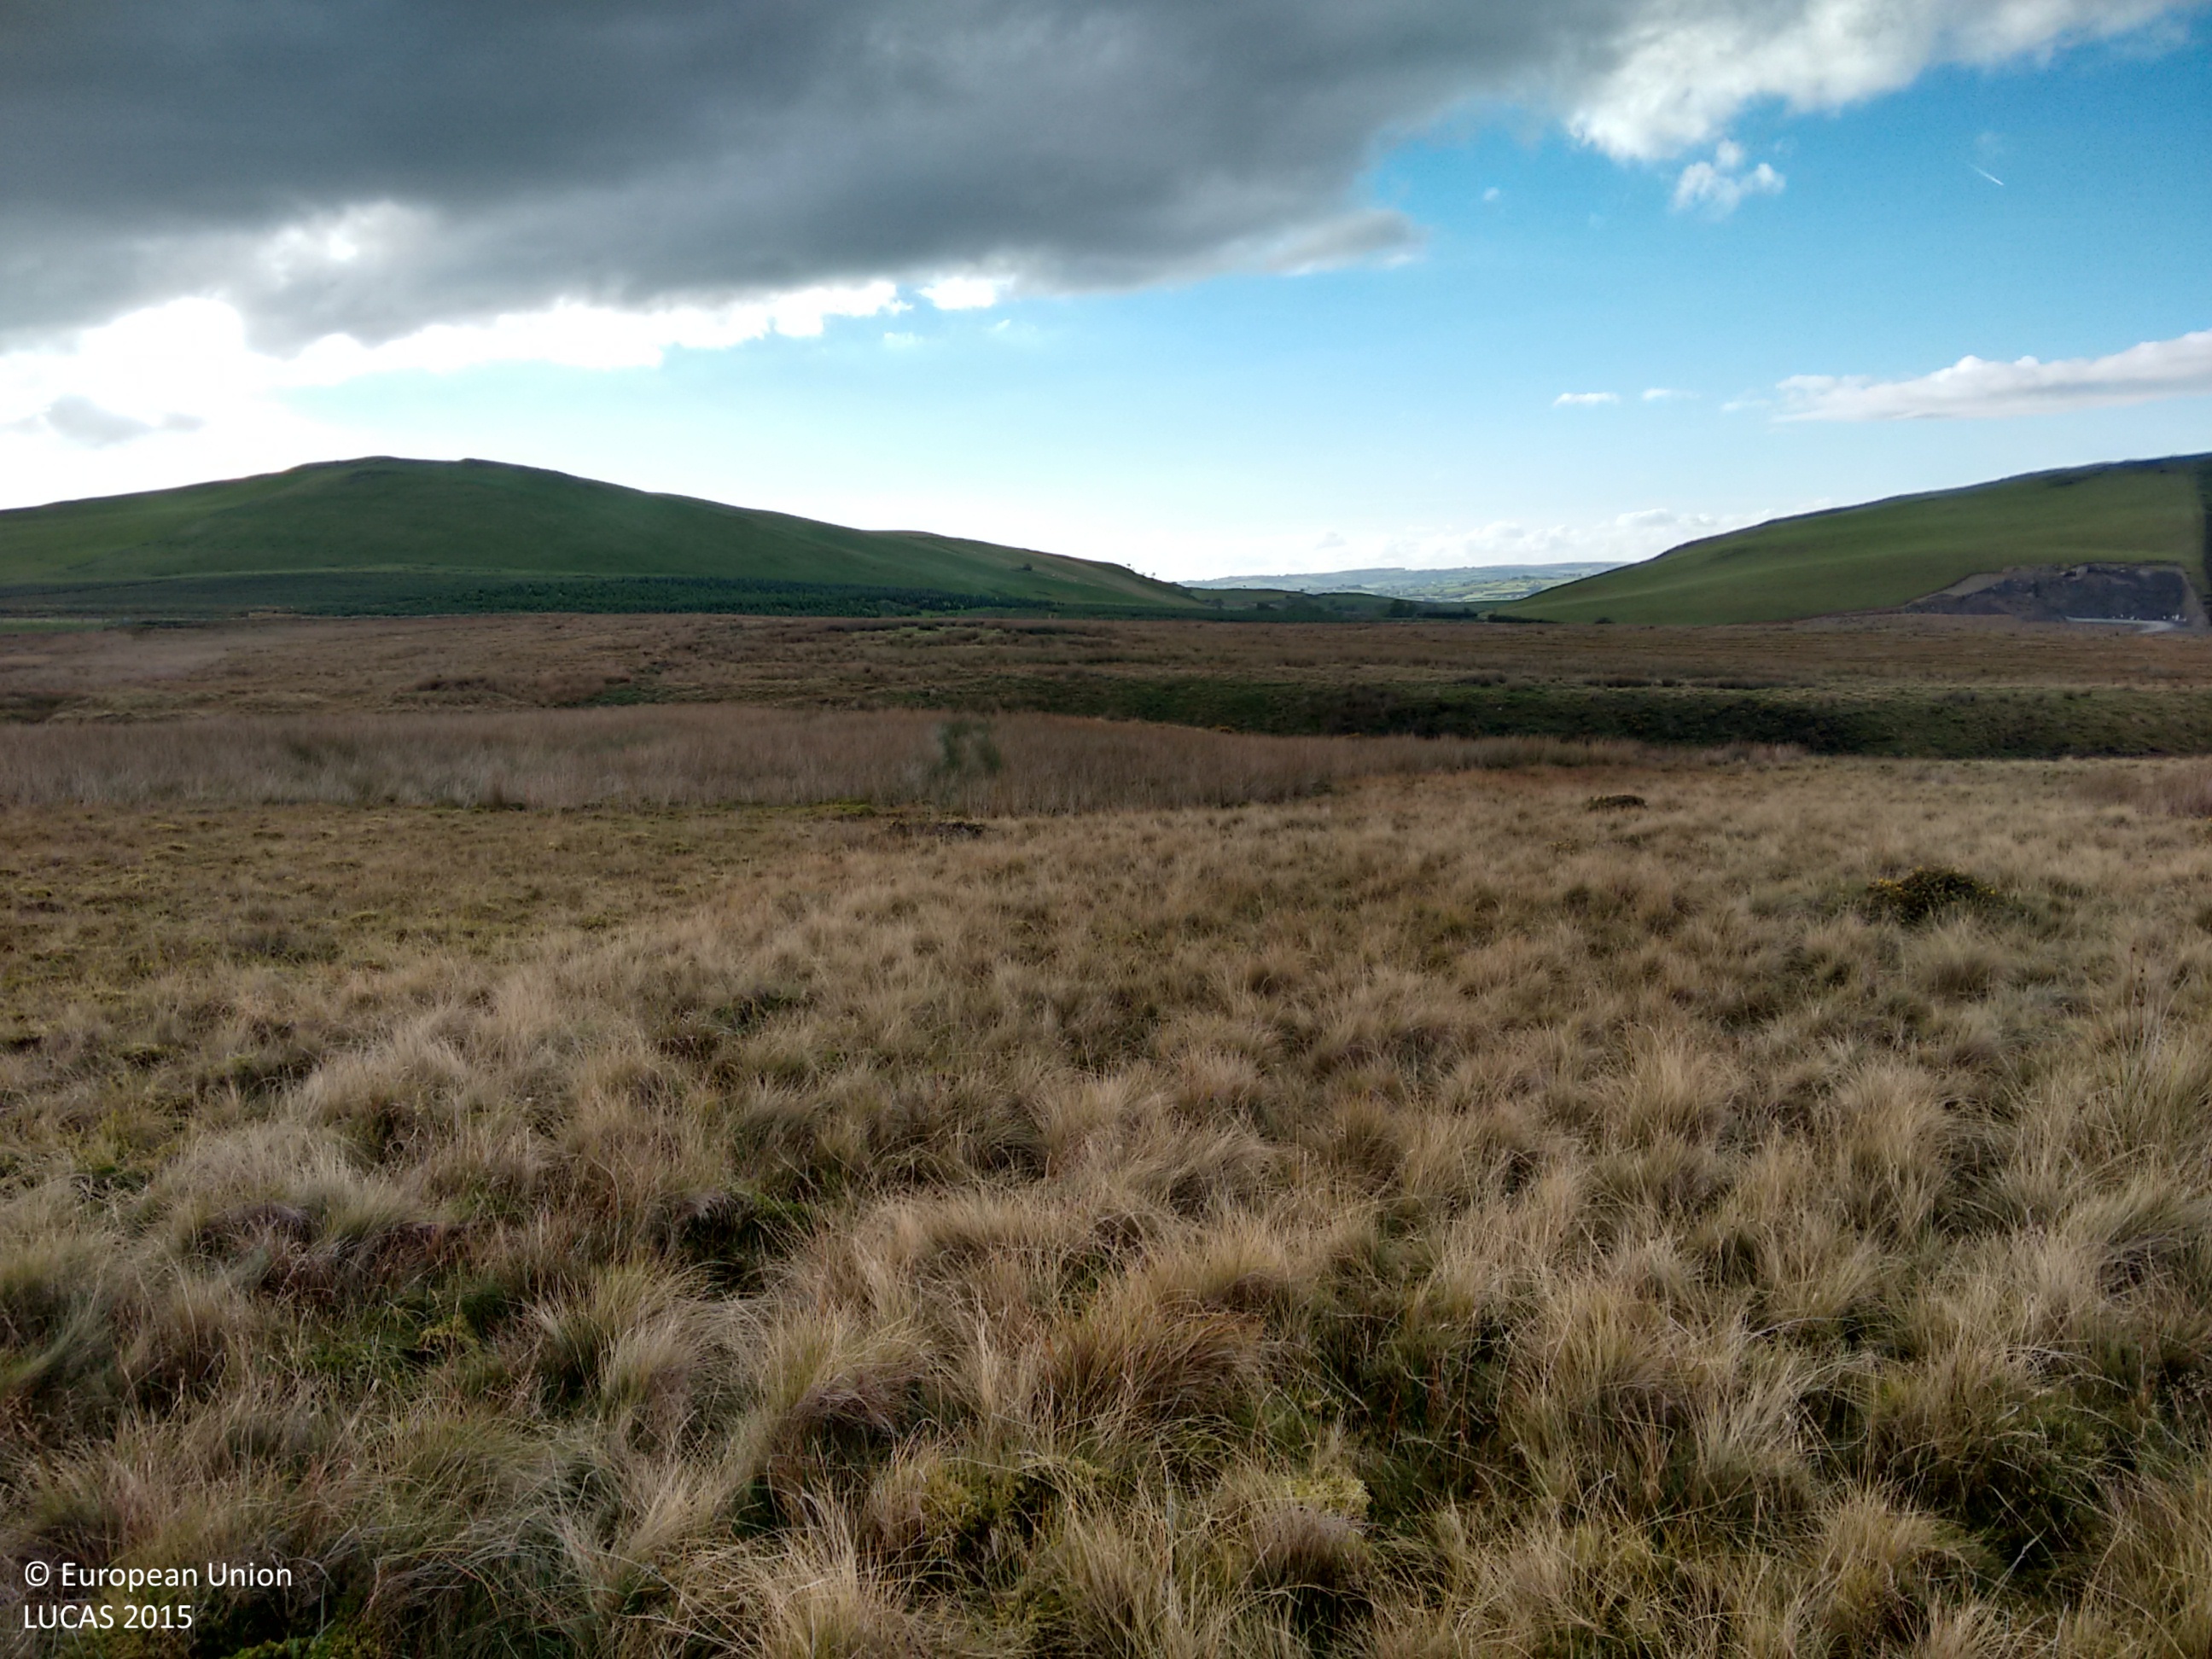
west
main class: Grassland
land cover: Grassland without tree/shrub cover
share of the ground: > 75 %
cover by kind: herbaceous plants 80 %, lichens and mosses 20 %
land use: Agriculture (excluding fallow land and kitchen gardens)
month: October
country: GB
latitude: 52.2509
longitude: -3.8758
